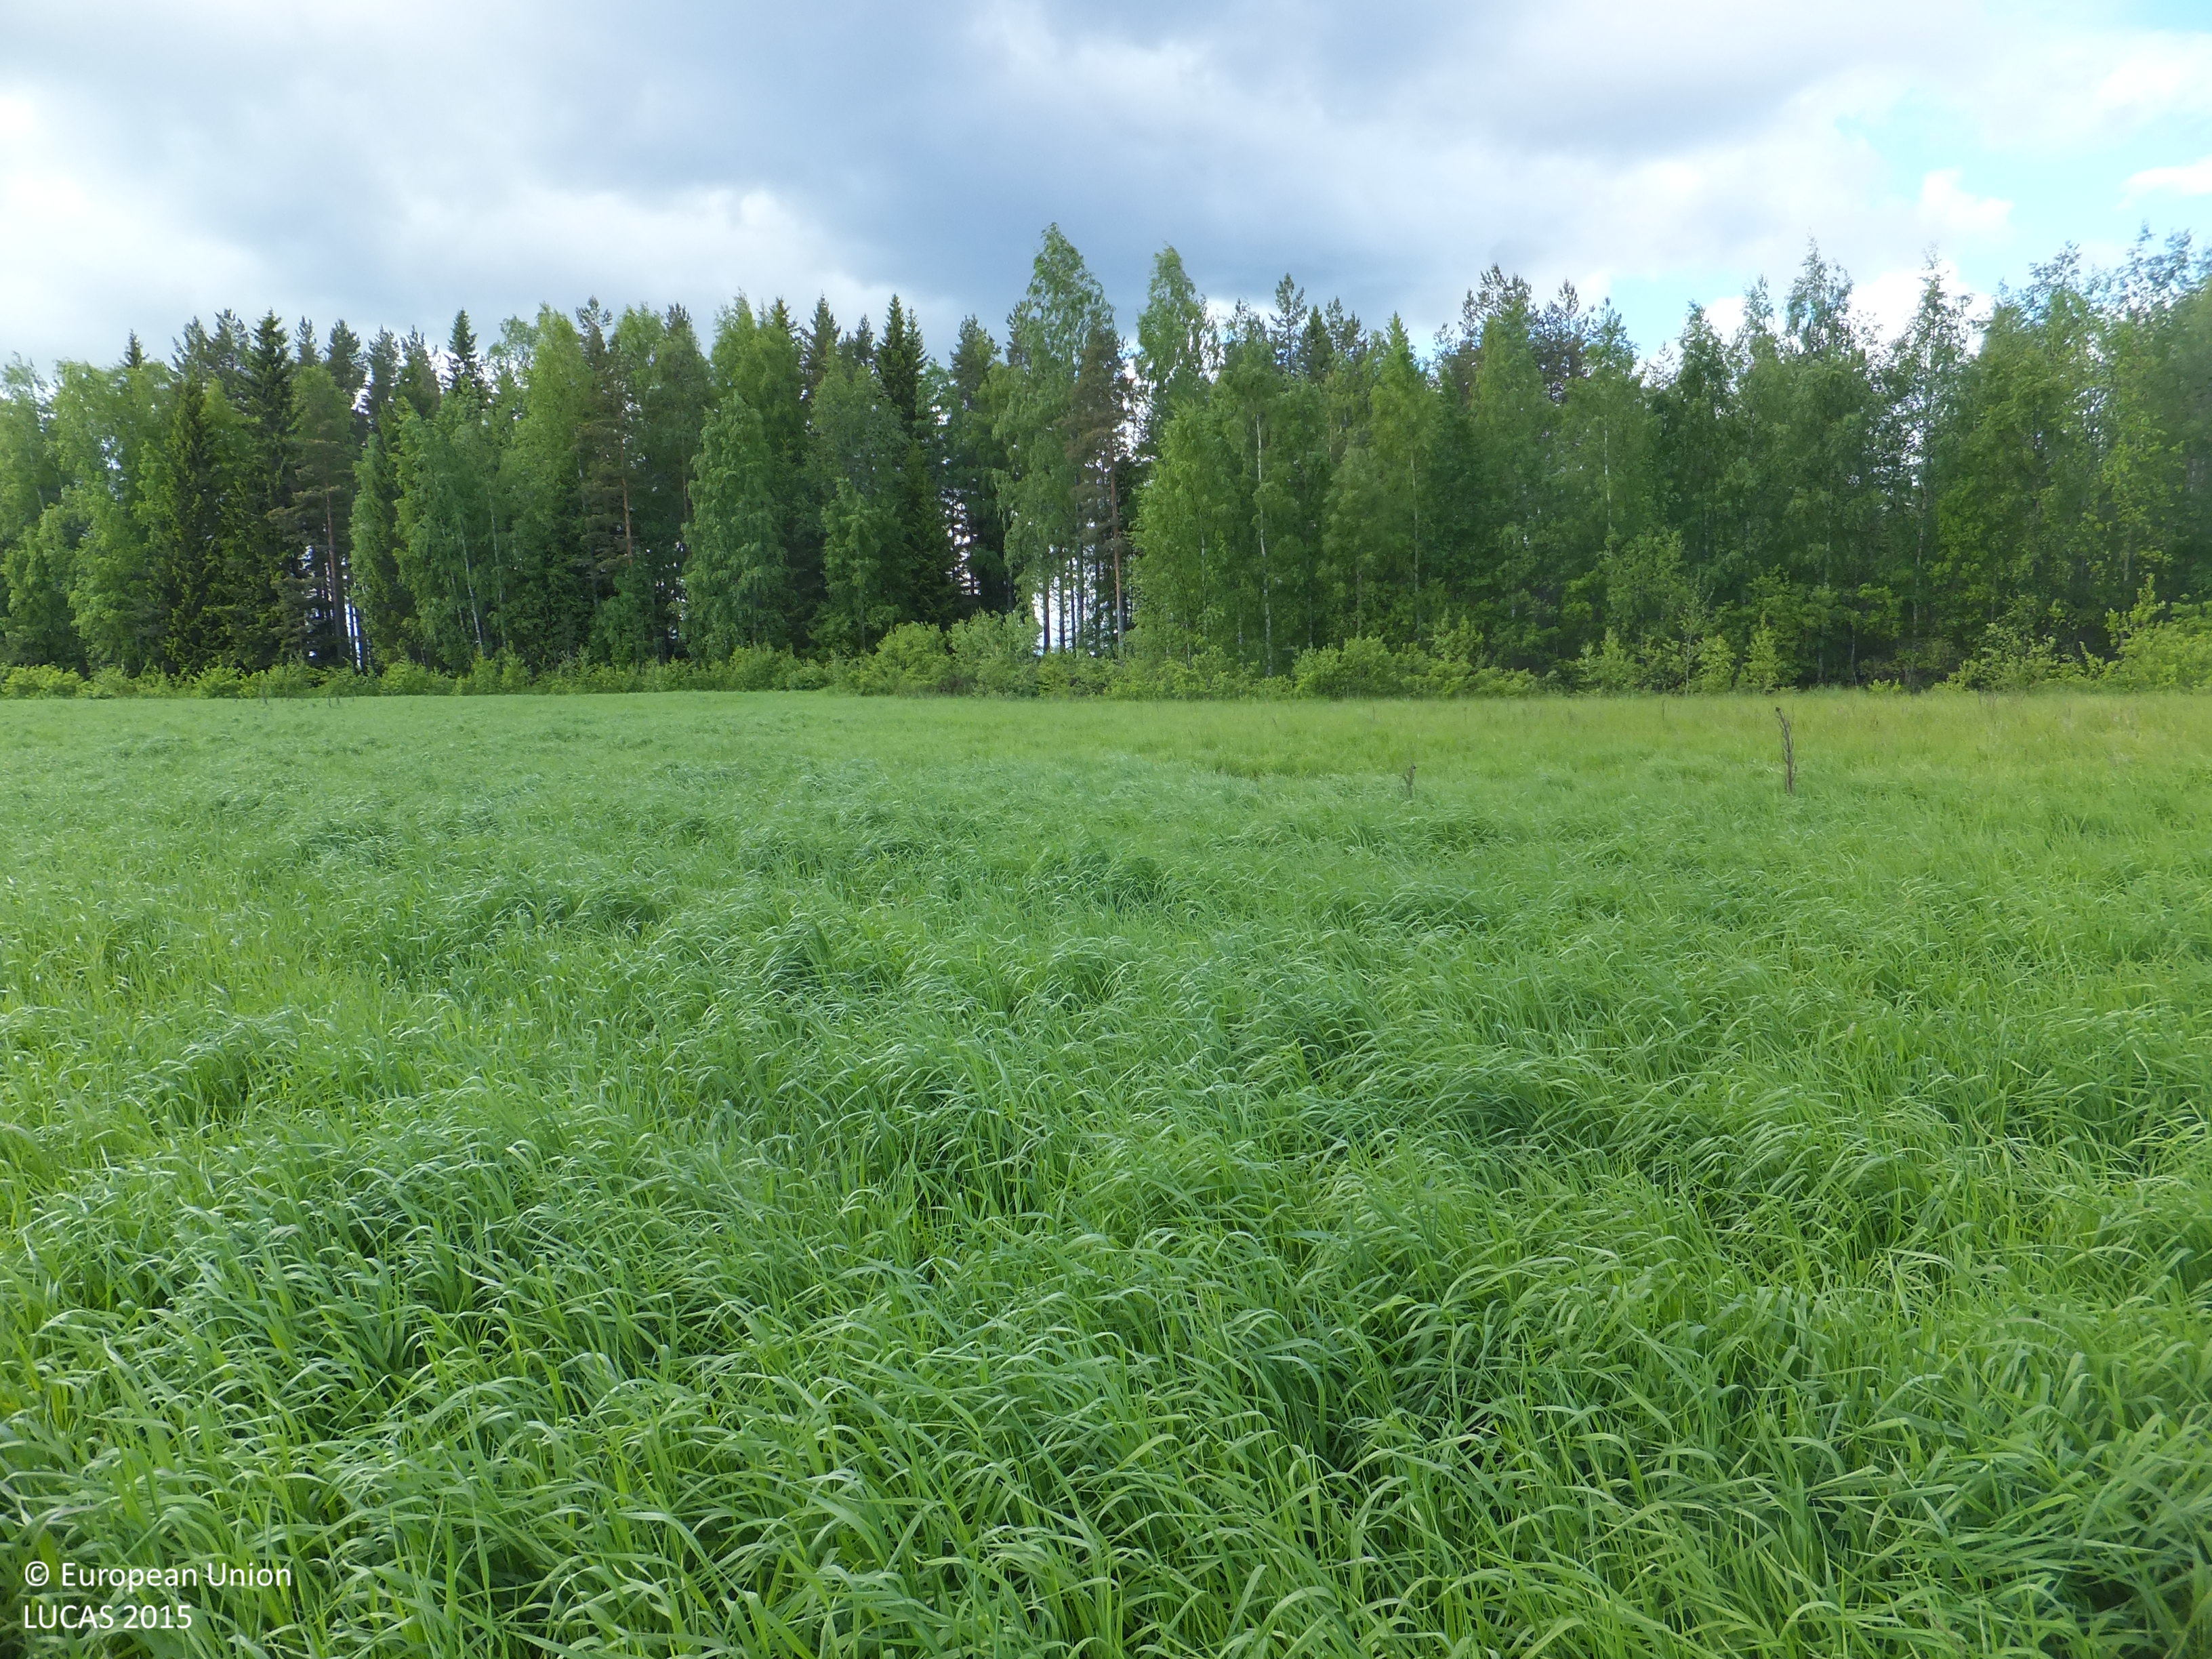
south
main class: Cropland
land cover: Temporary grasslands
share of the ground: > 75 %
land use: Agriculture (excluding fallow land and kitchen gardens)
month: June
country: FI
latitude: 63.5341
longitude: 24.7871
